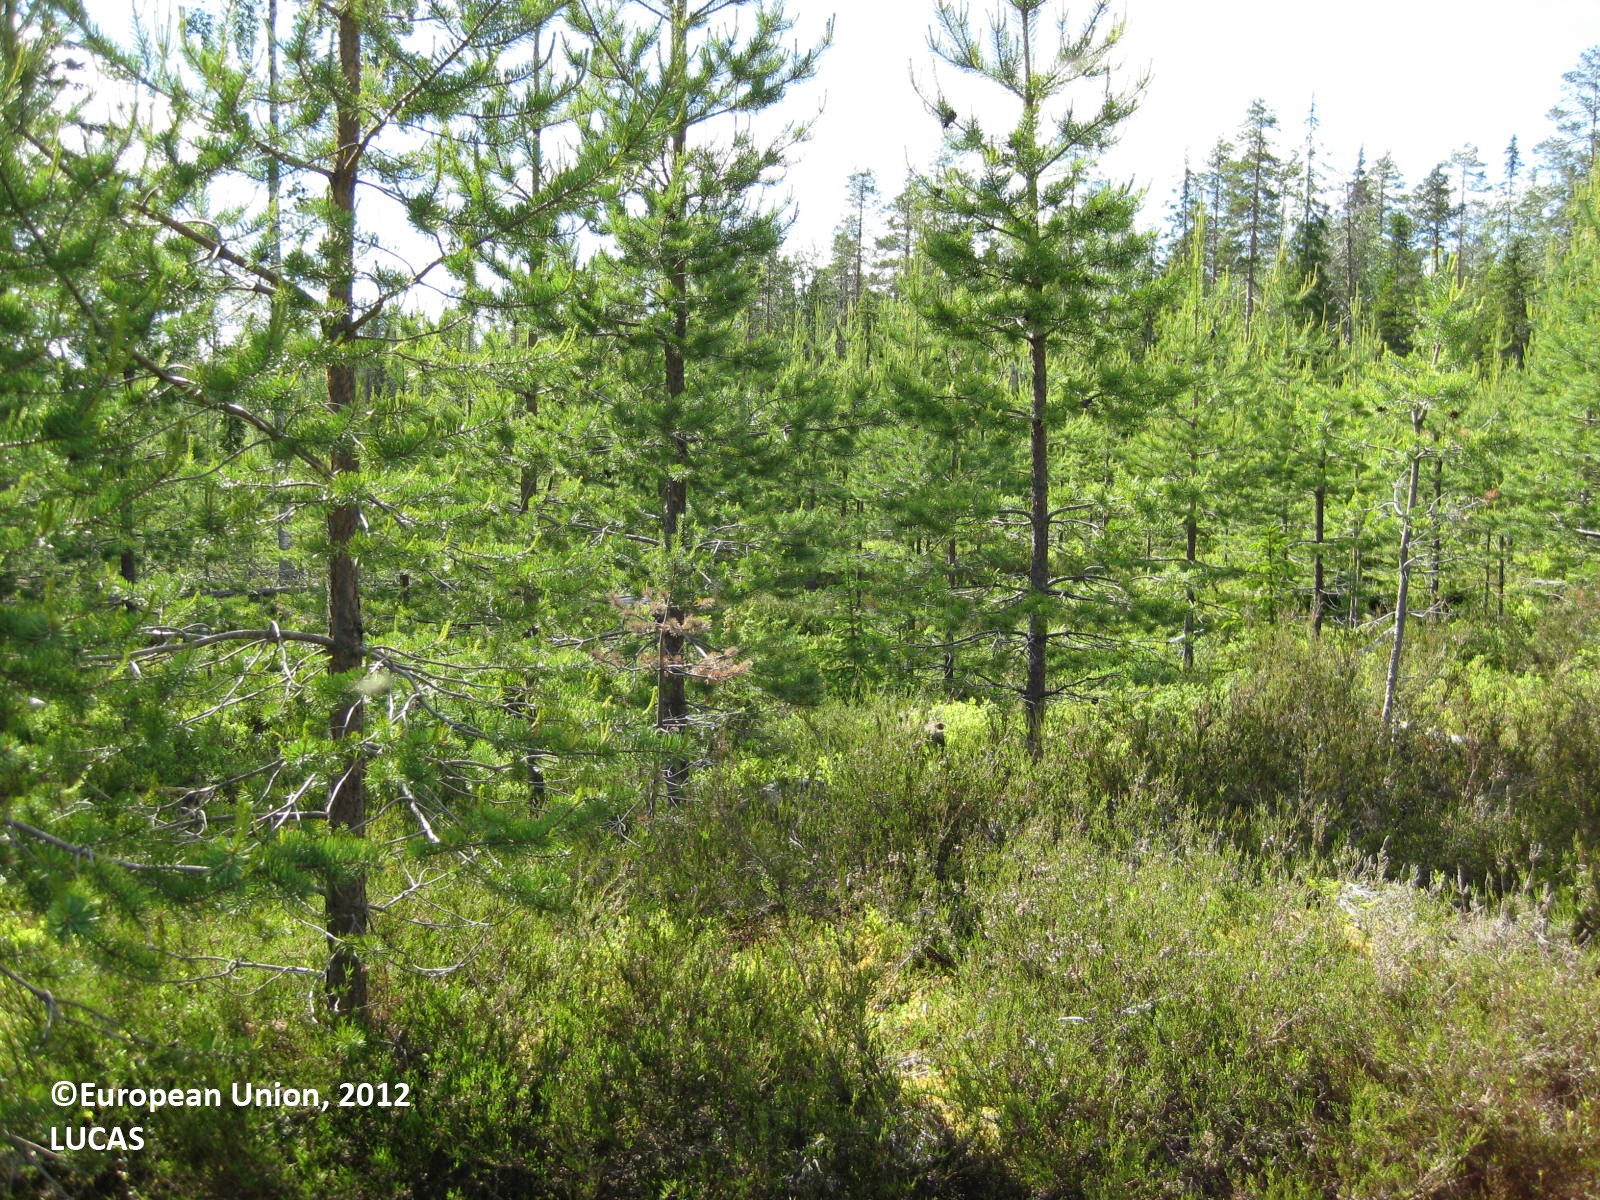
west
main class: Woodland
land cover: Pine dominated coniferous woodland
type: boreal forest
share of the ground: > 75 %
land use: Forestry
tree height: > 5 m
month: July
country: FI
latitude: 65.5962
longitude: 29.4343
